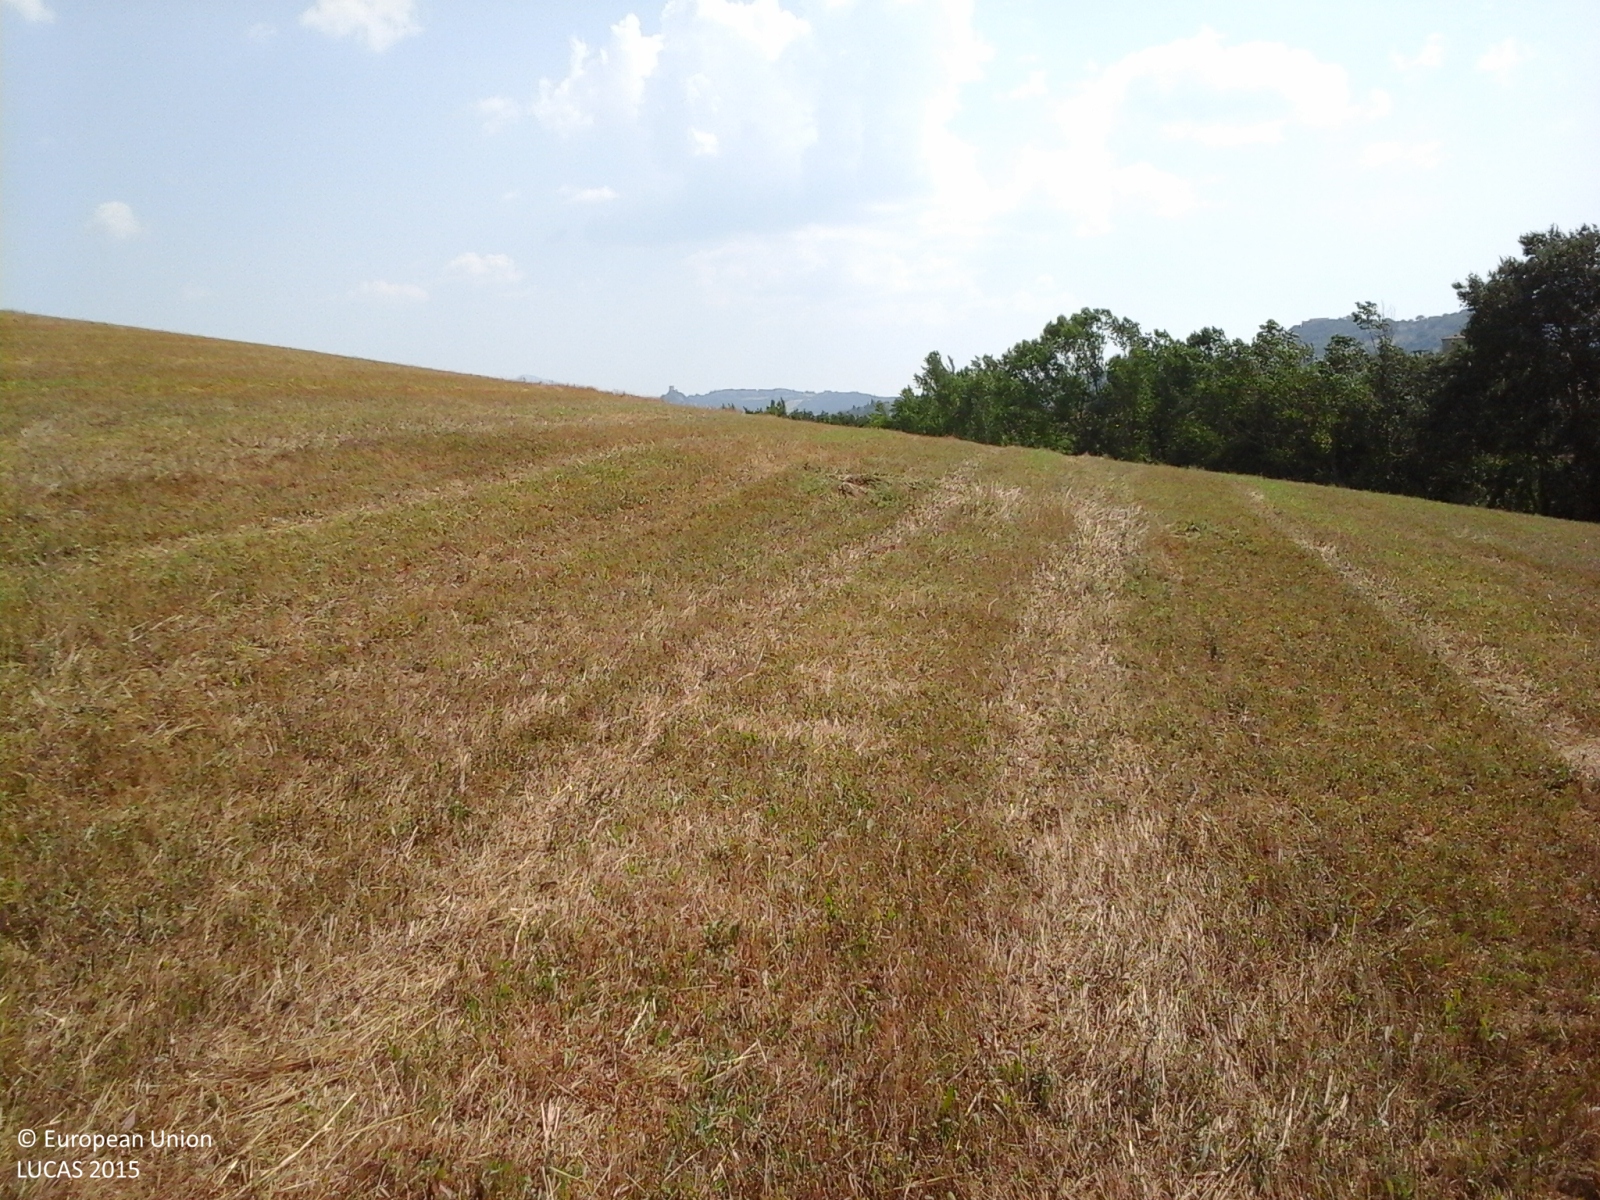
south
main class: Cropland
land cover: Oats
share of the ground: > 75 %
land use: Agriculture (excluding fallow land and kitchen gardens)
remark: Harvested field
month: July
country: IT
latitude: 43.0564
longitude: 11.6280
